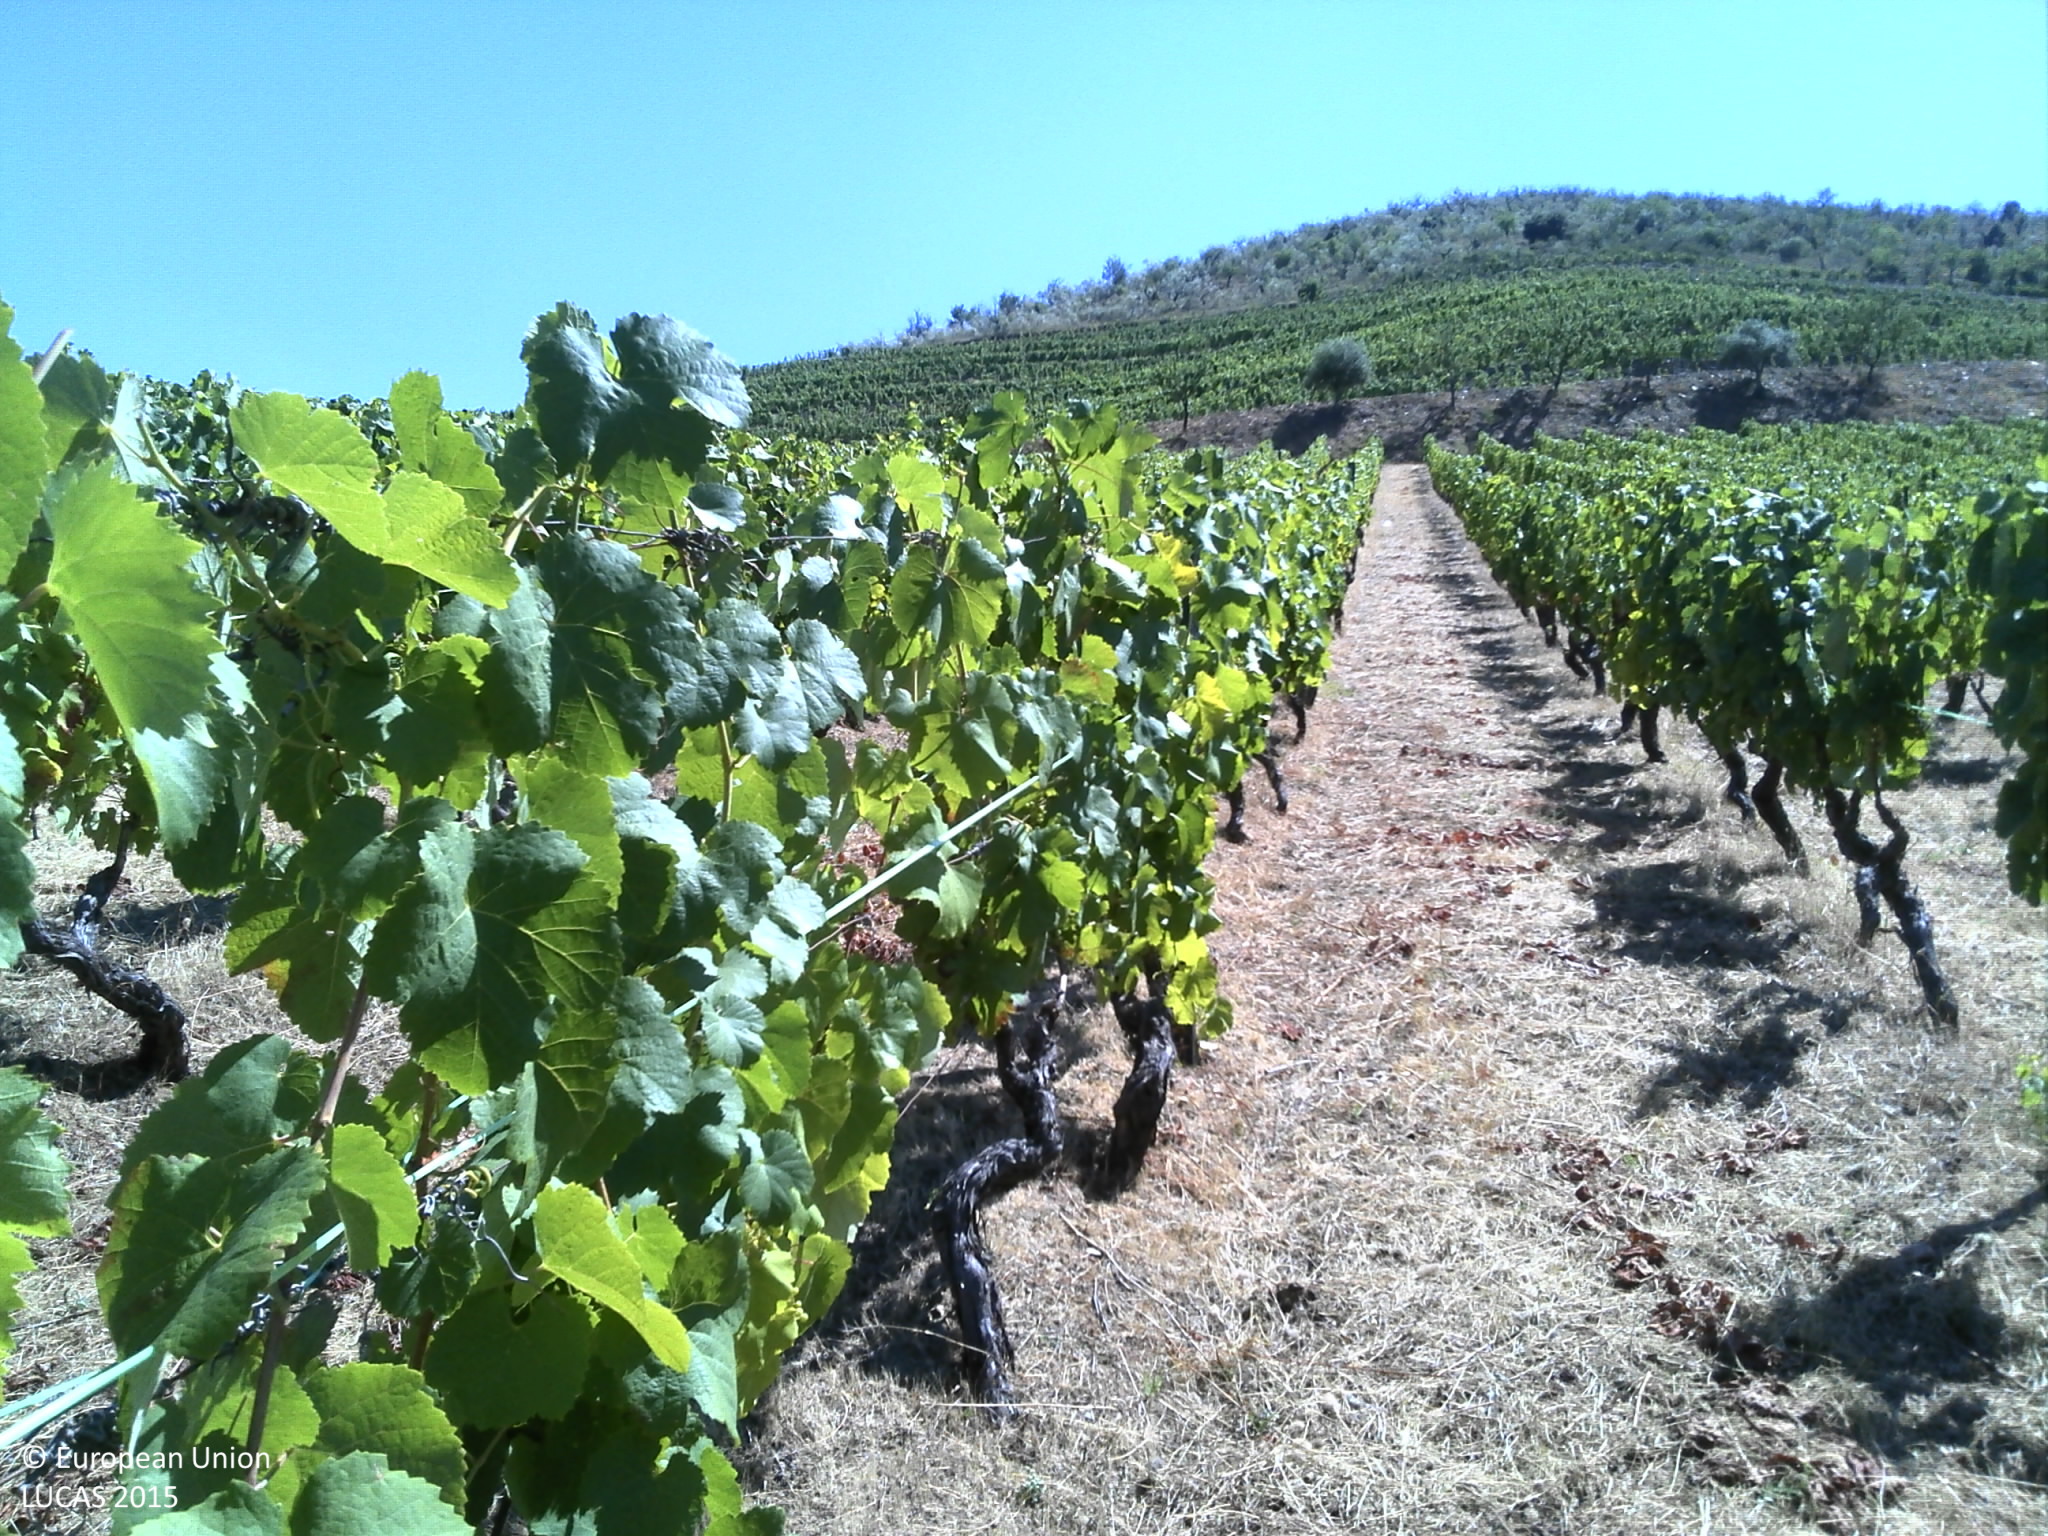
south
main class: Cropland
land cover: Vineyards
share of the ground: 10 - 25 %
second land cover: Grassland without tree/shrub cover
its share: > 75 %
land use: Agriculture (excluding fallow land and kitchen gardens)
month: June
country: PT
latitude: 41.0273
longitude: -6.9593
